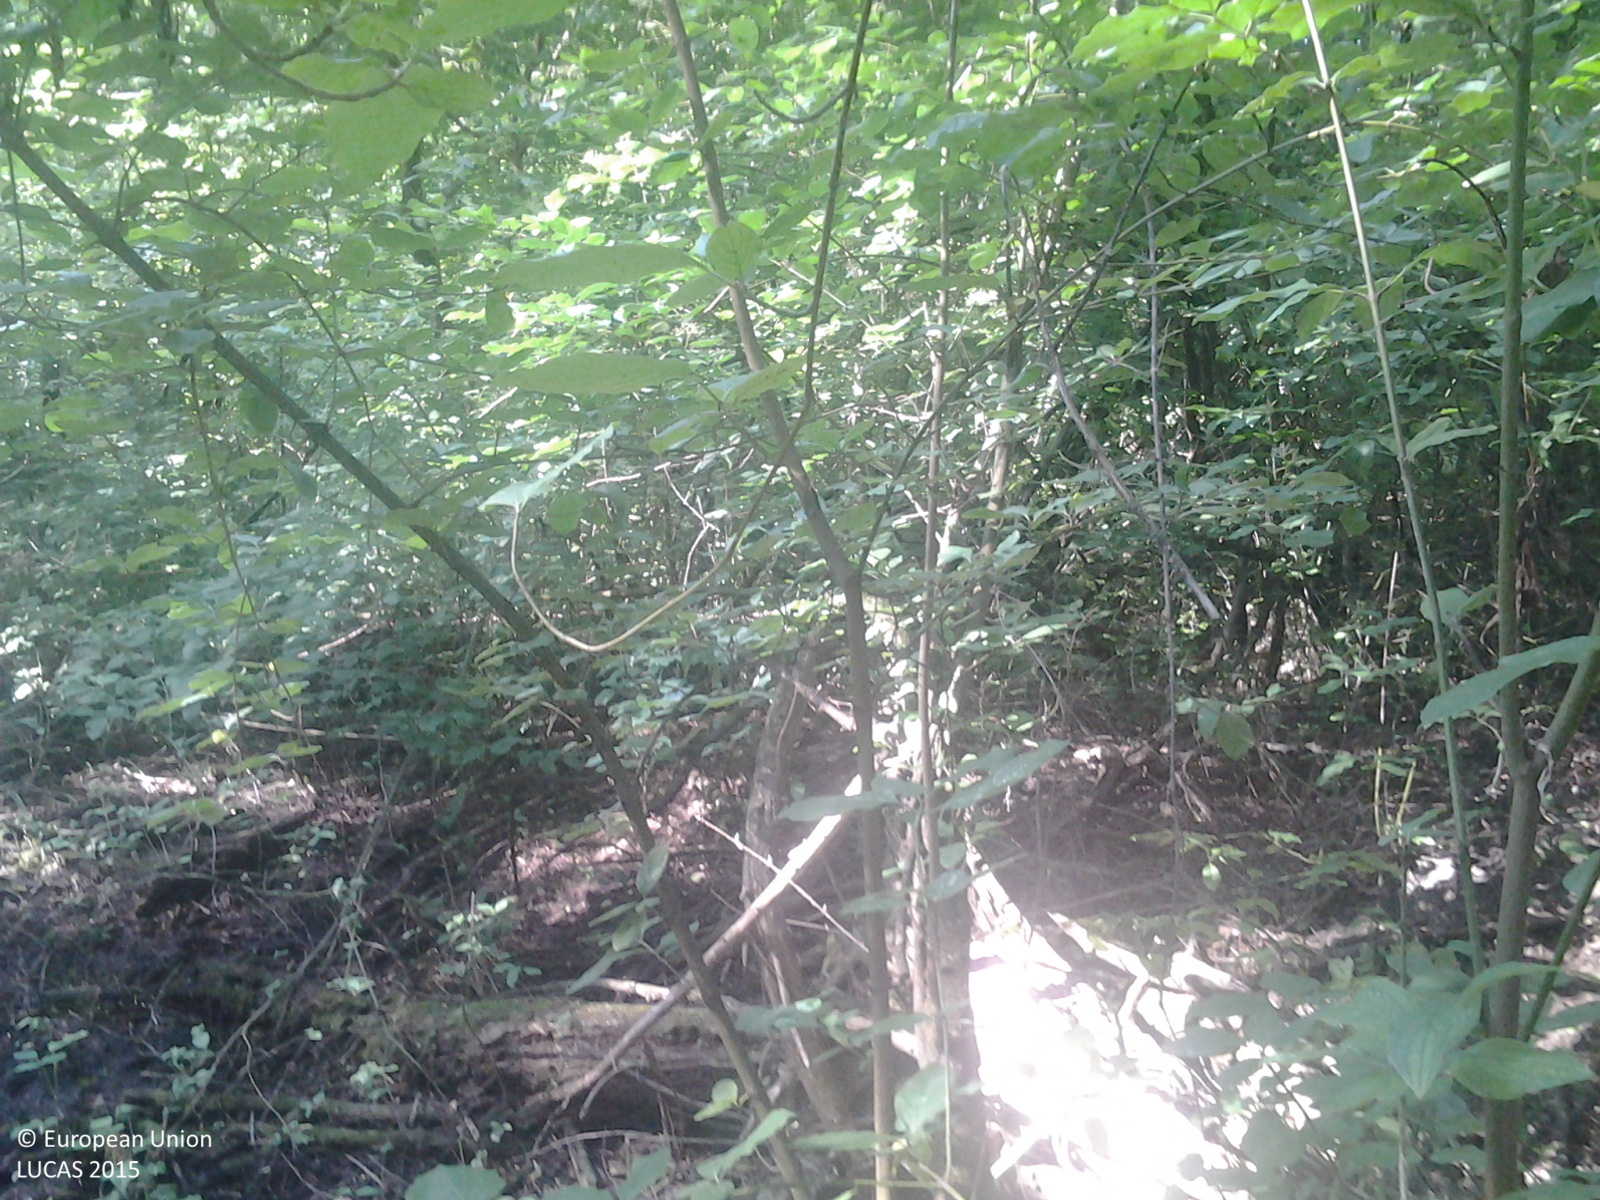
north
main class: Woodland
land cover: Broadleaved woodland
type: mesophytic deciduous forest
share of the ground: > 75 %
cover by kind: broadleaved forest trees 95 %, shrubs 5 %
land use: Forestry
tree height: > 5 m
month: June
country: HU
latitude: 46.6069
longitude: 19.1937
